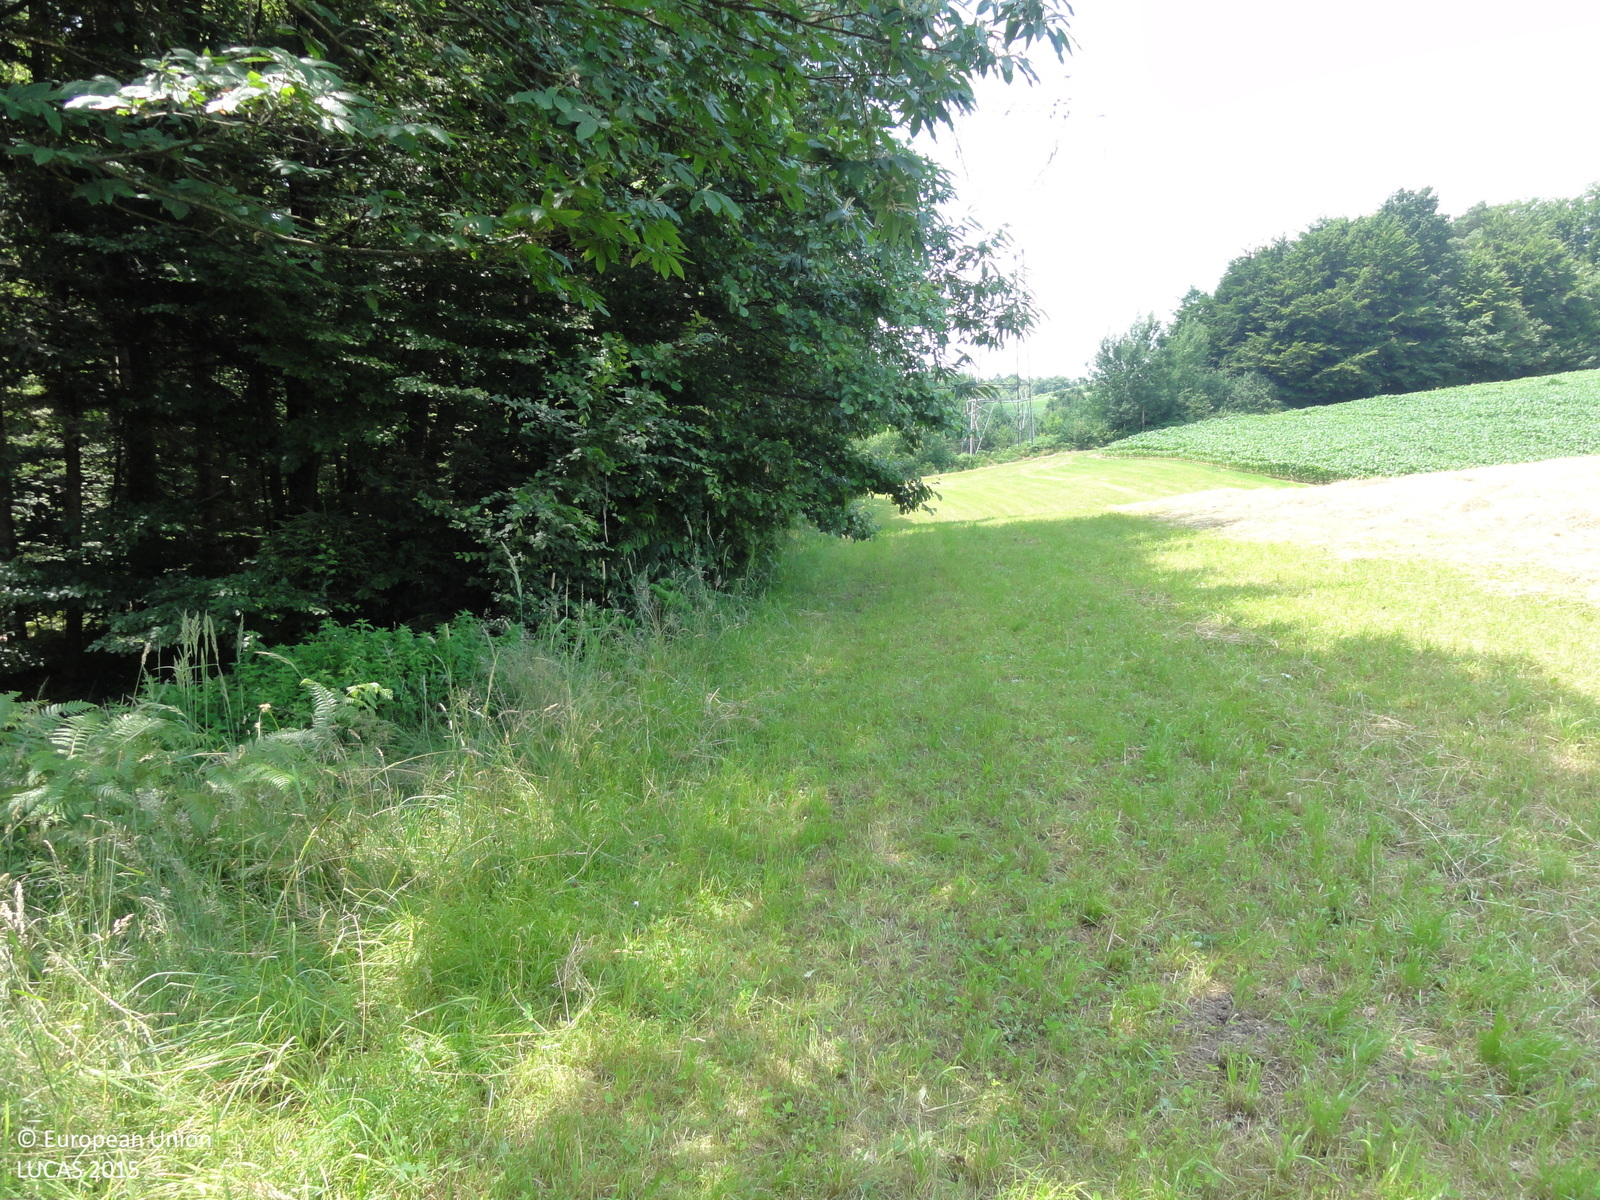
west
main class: Grassland
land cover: Grassland without tree/shrub cover
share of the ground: > 75 %
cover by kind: herbaceous plants 100 %
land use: Agriculture (excluding fallow land and kitchen gardens)
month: July
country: SI
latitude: 46.3351
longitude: 15.5195
